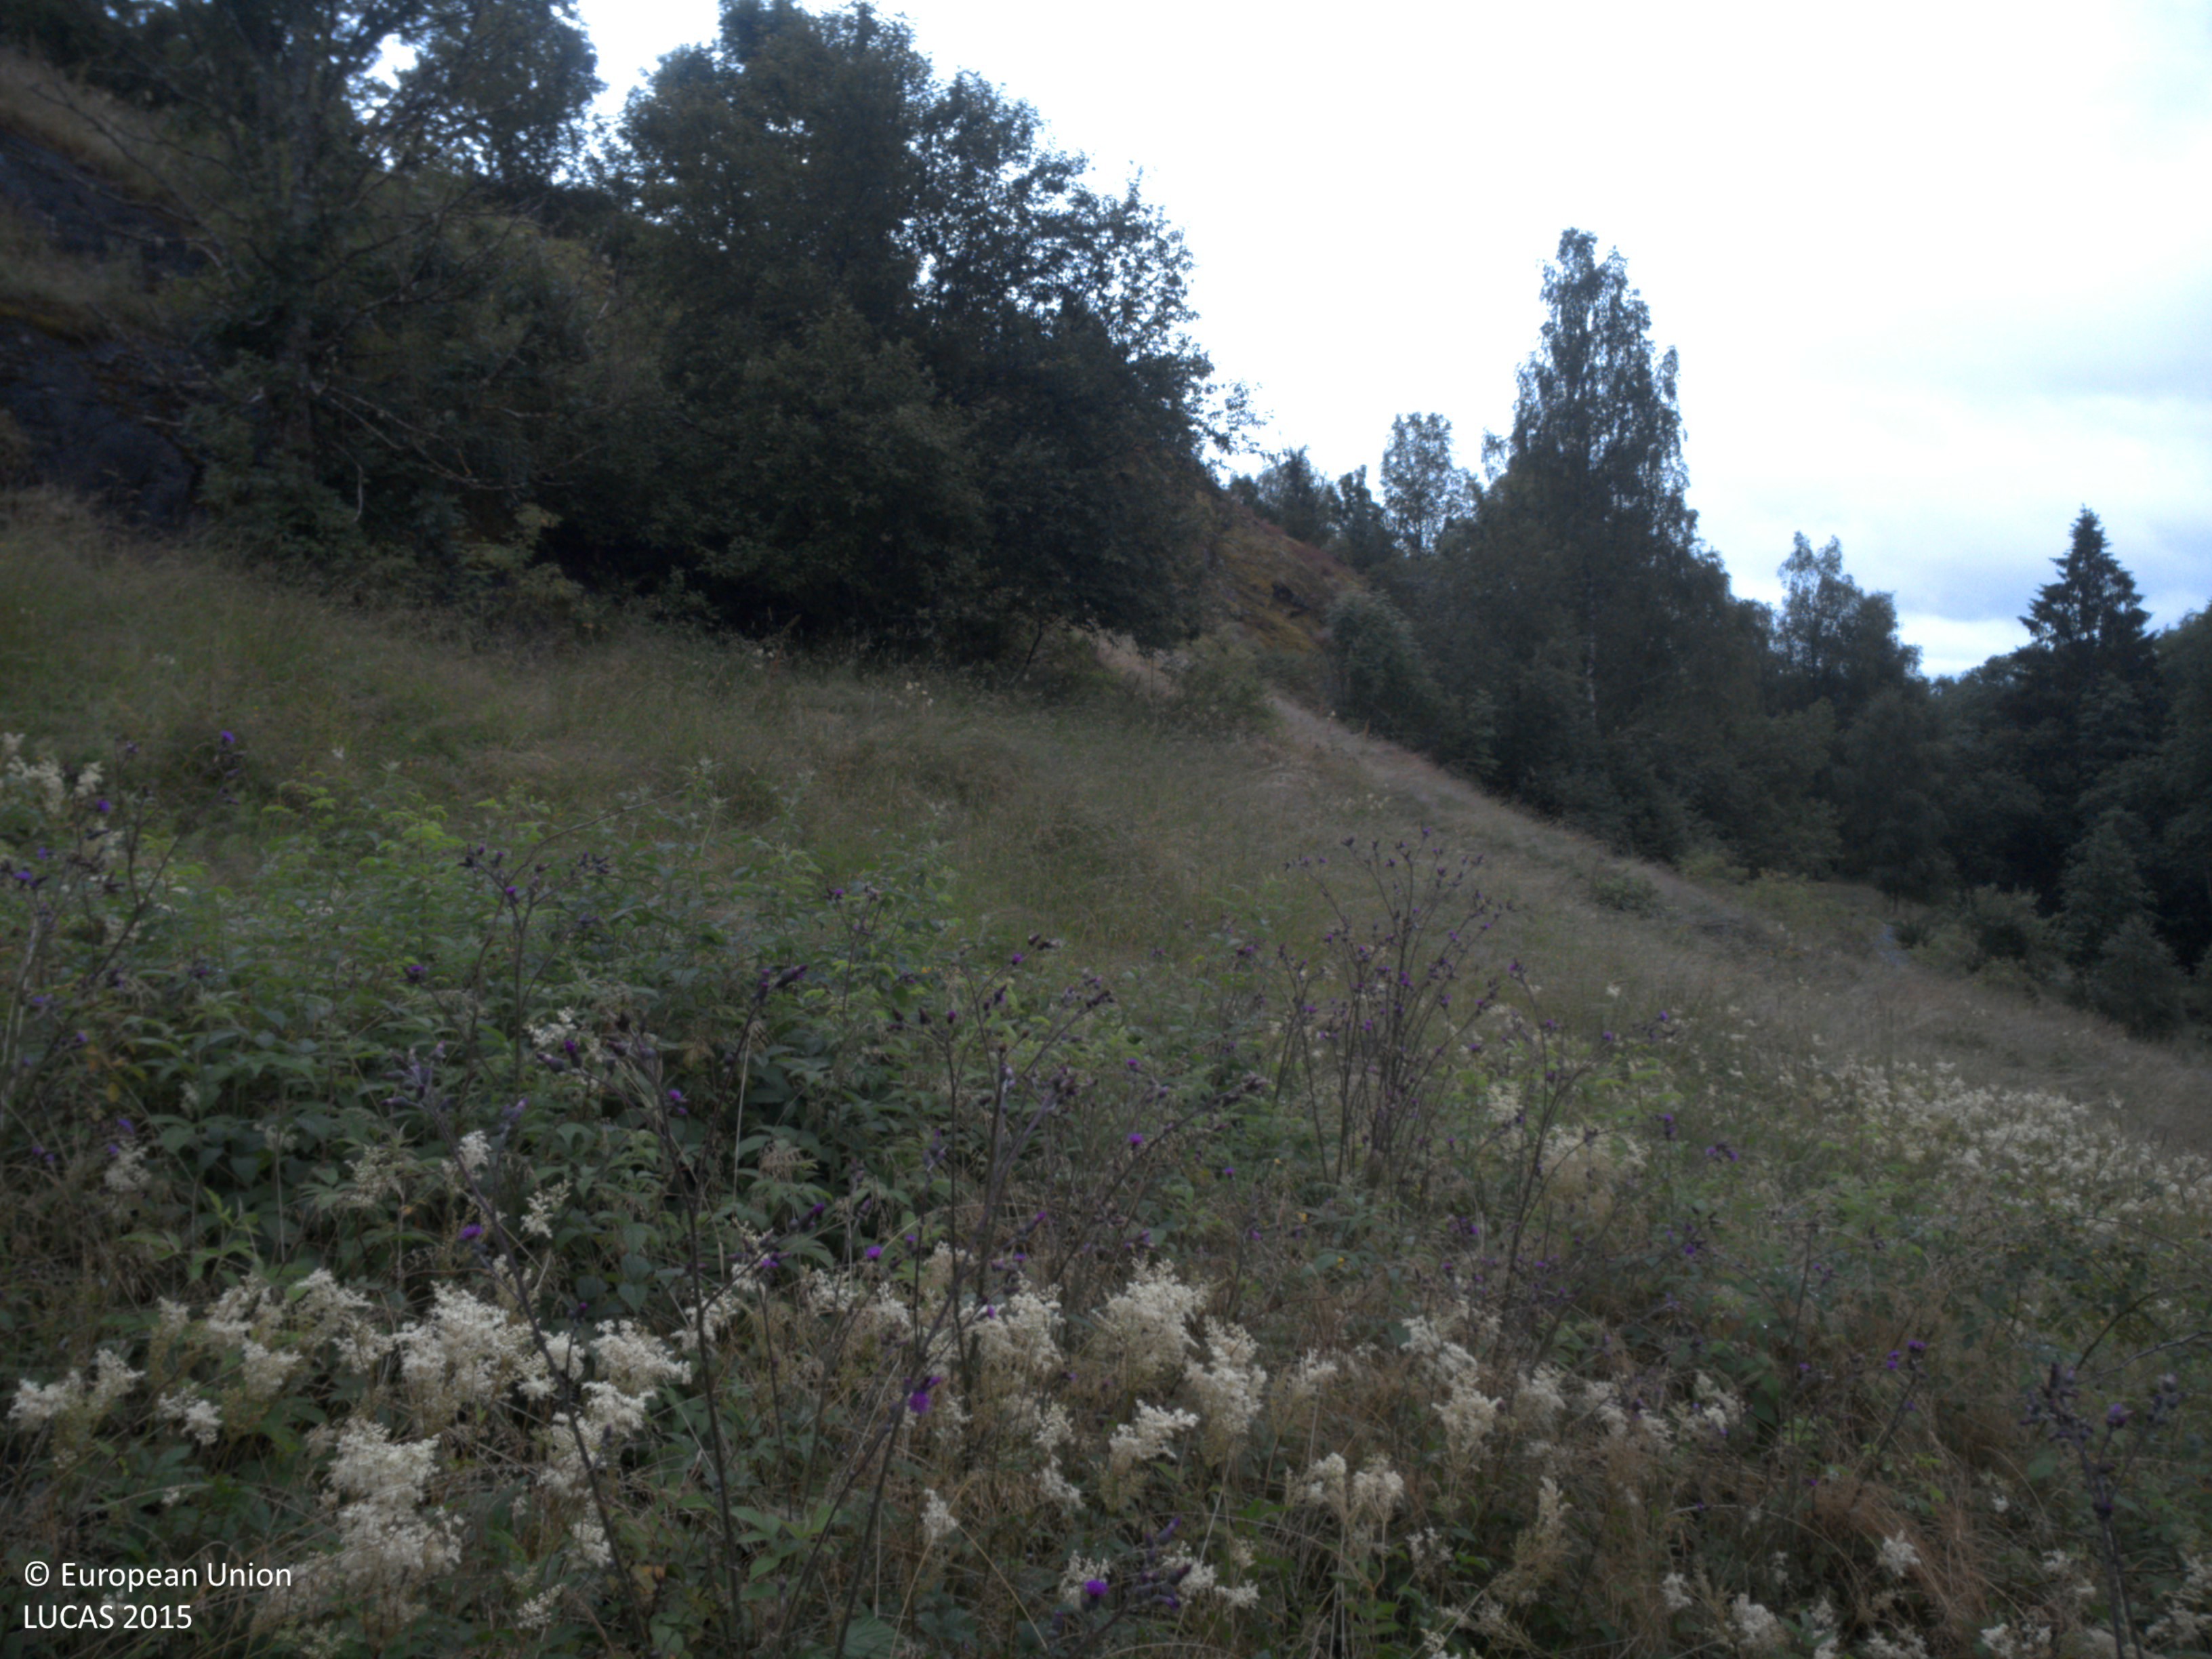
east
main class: Shrubland
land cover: Shrubland with sparse tree cover
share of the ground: > 75 %
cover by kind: herbaceous plants 80 %, shrubs 15 %, broadleaved forest trees 5 %
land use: Agriculture (excluding fallow land and kitchen gardens)
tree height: < 5 m
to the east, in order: Shrubland with sparse tree cover; Grassland with sparse tree/shrub cover; Single bushes/trees; Grassland with sparse tree/shrub cover; Broadleaved woodland; Rocks and stones; Grassland without tree/shrub cover; Pine dominated mixed woodland; Grassland without tree/shrub cover; Fences; Shrubland with sparse tree cover; Broadleaved woodland
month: July
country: SE
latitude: 58.7281
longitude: 11.8784
